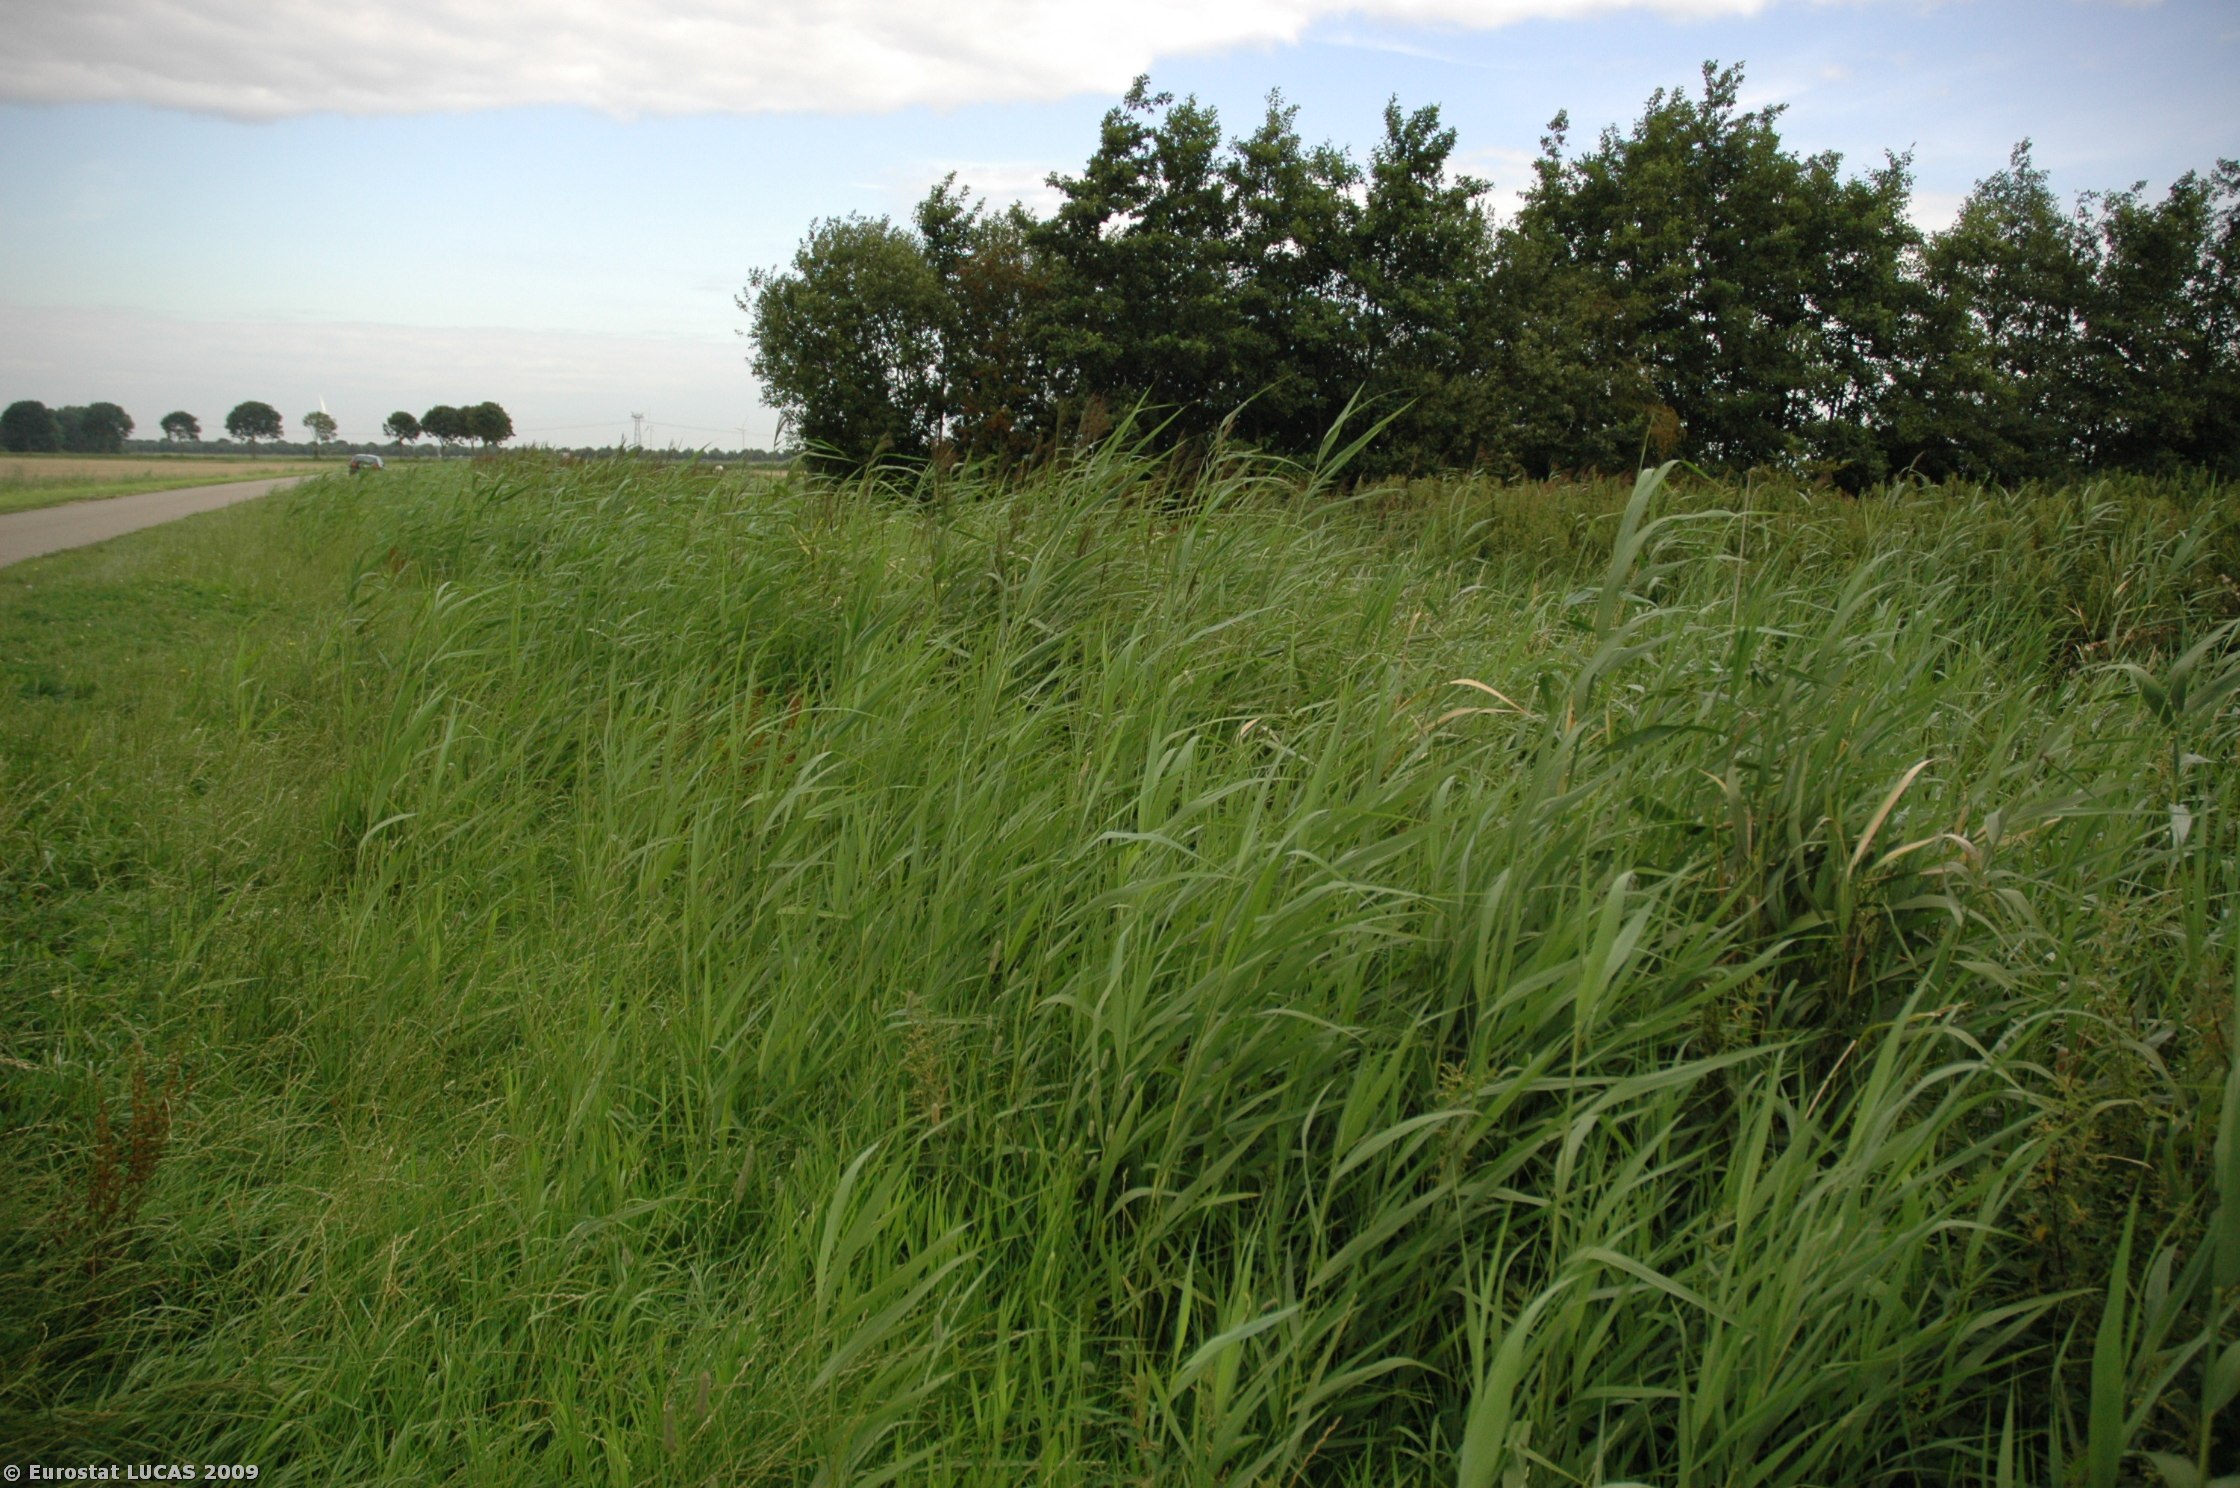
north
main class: Grassland
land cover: Grassland without tree/shrub cover
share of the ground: > 75 %
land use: Agriculture (excluding fallow land and kitchen gardens)
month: August
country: NL
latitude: 52.3055
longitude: 5.3783
